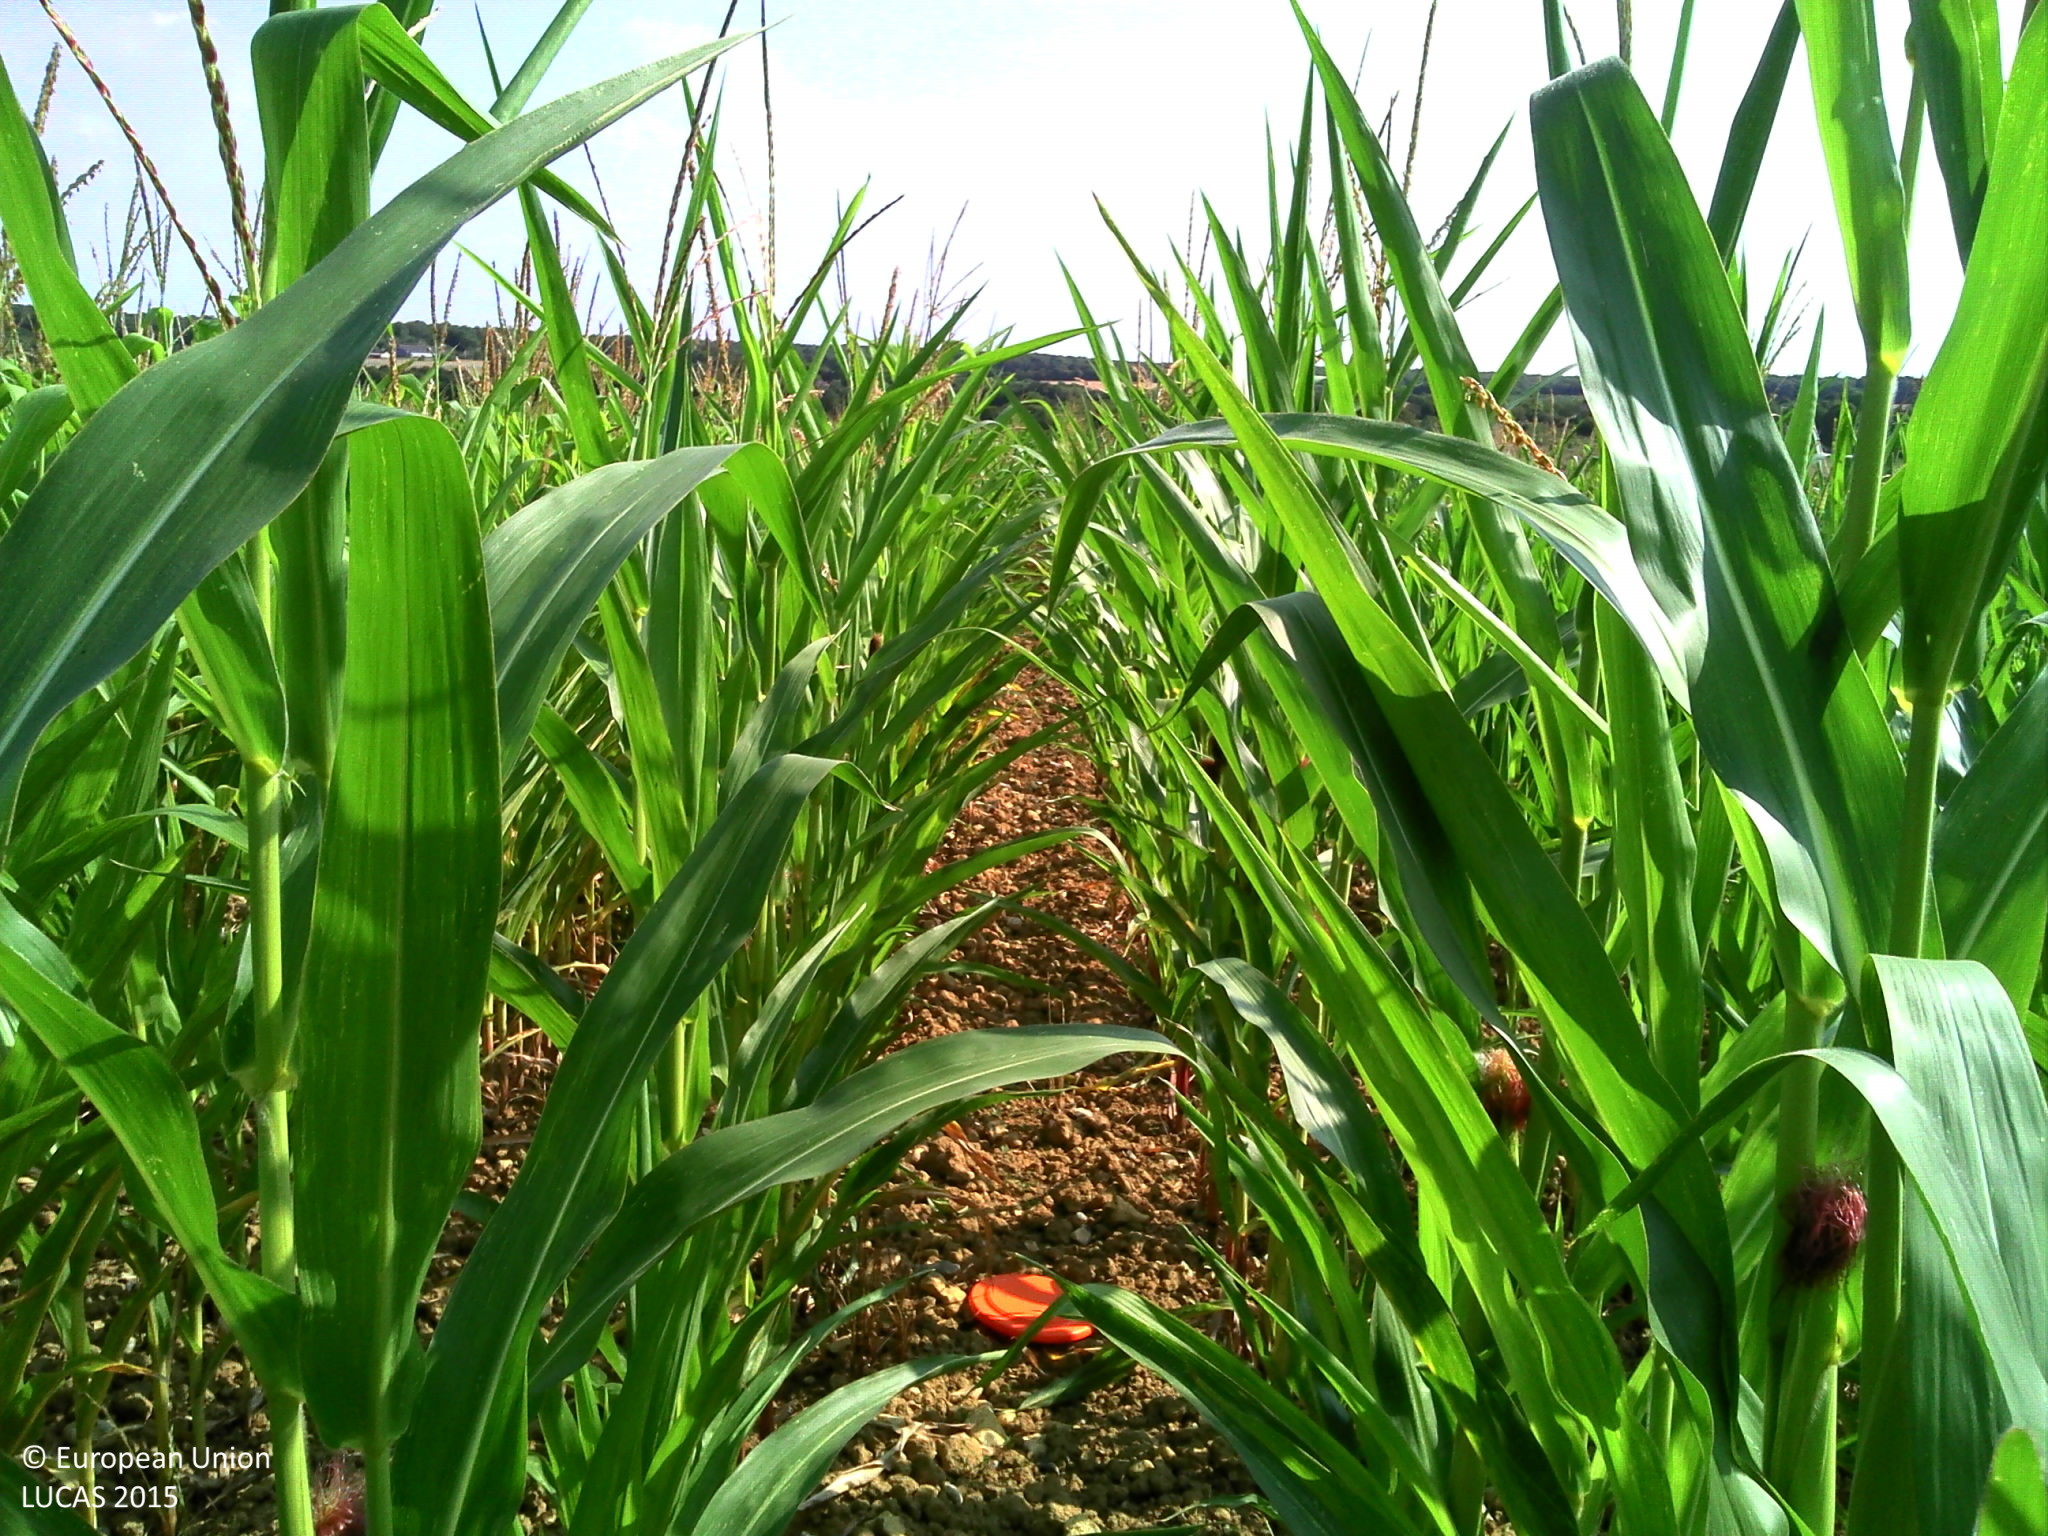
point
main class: Cropland
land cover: Maize
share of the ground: > 75 %
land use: Agriculture (excluding fallow land and kitchen gardens)
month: August
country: FR
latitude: 47.7039
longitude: 3.1578
